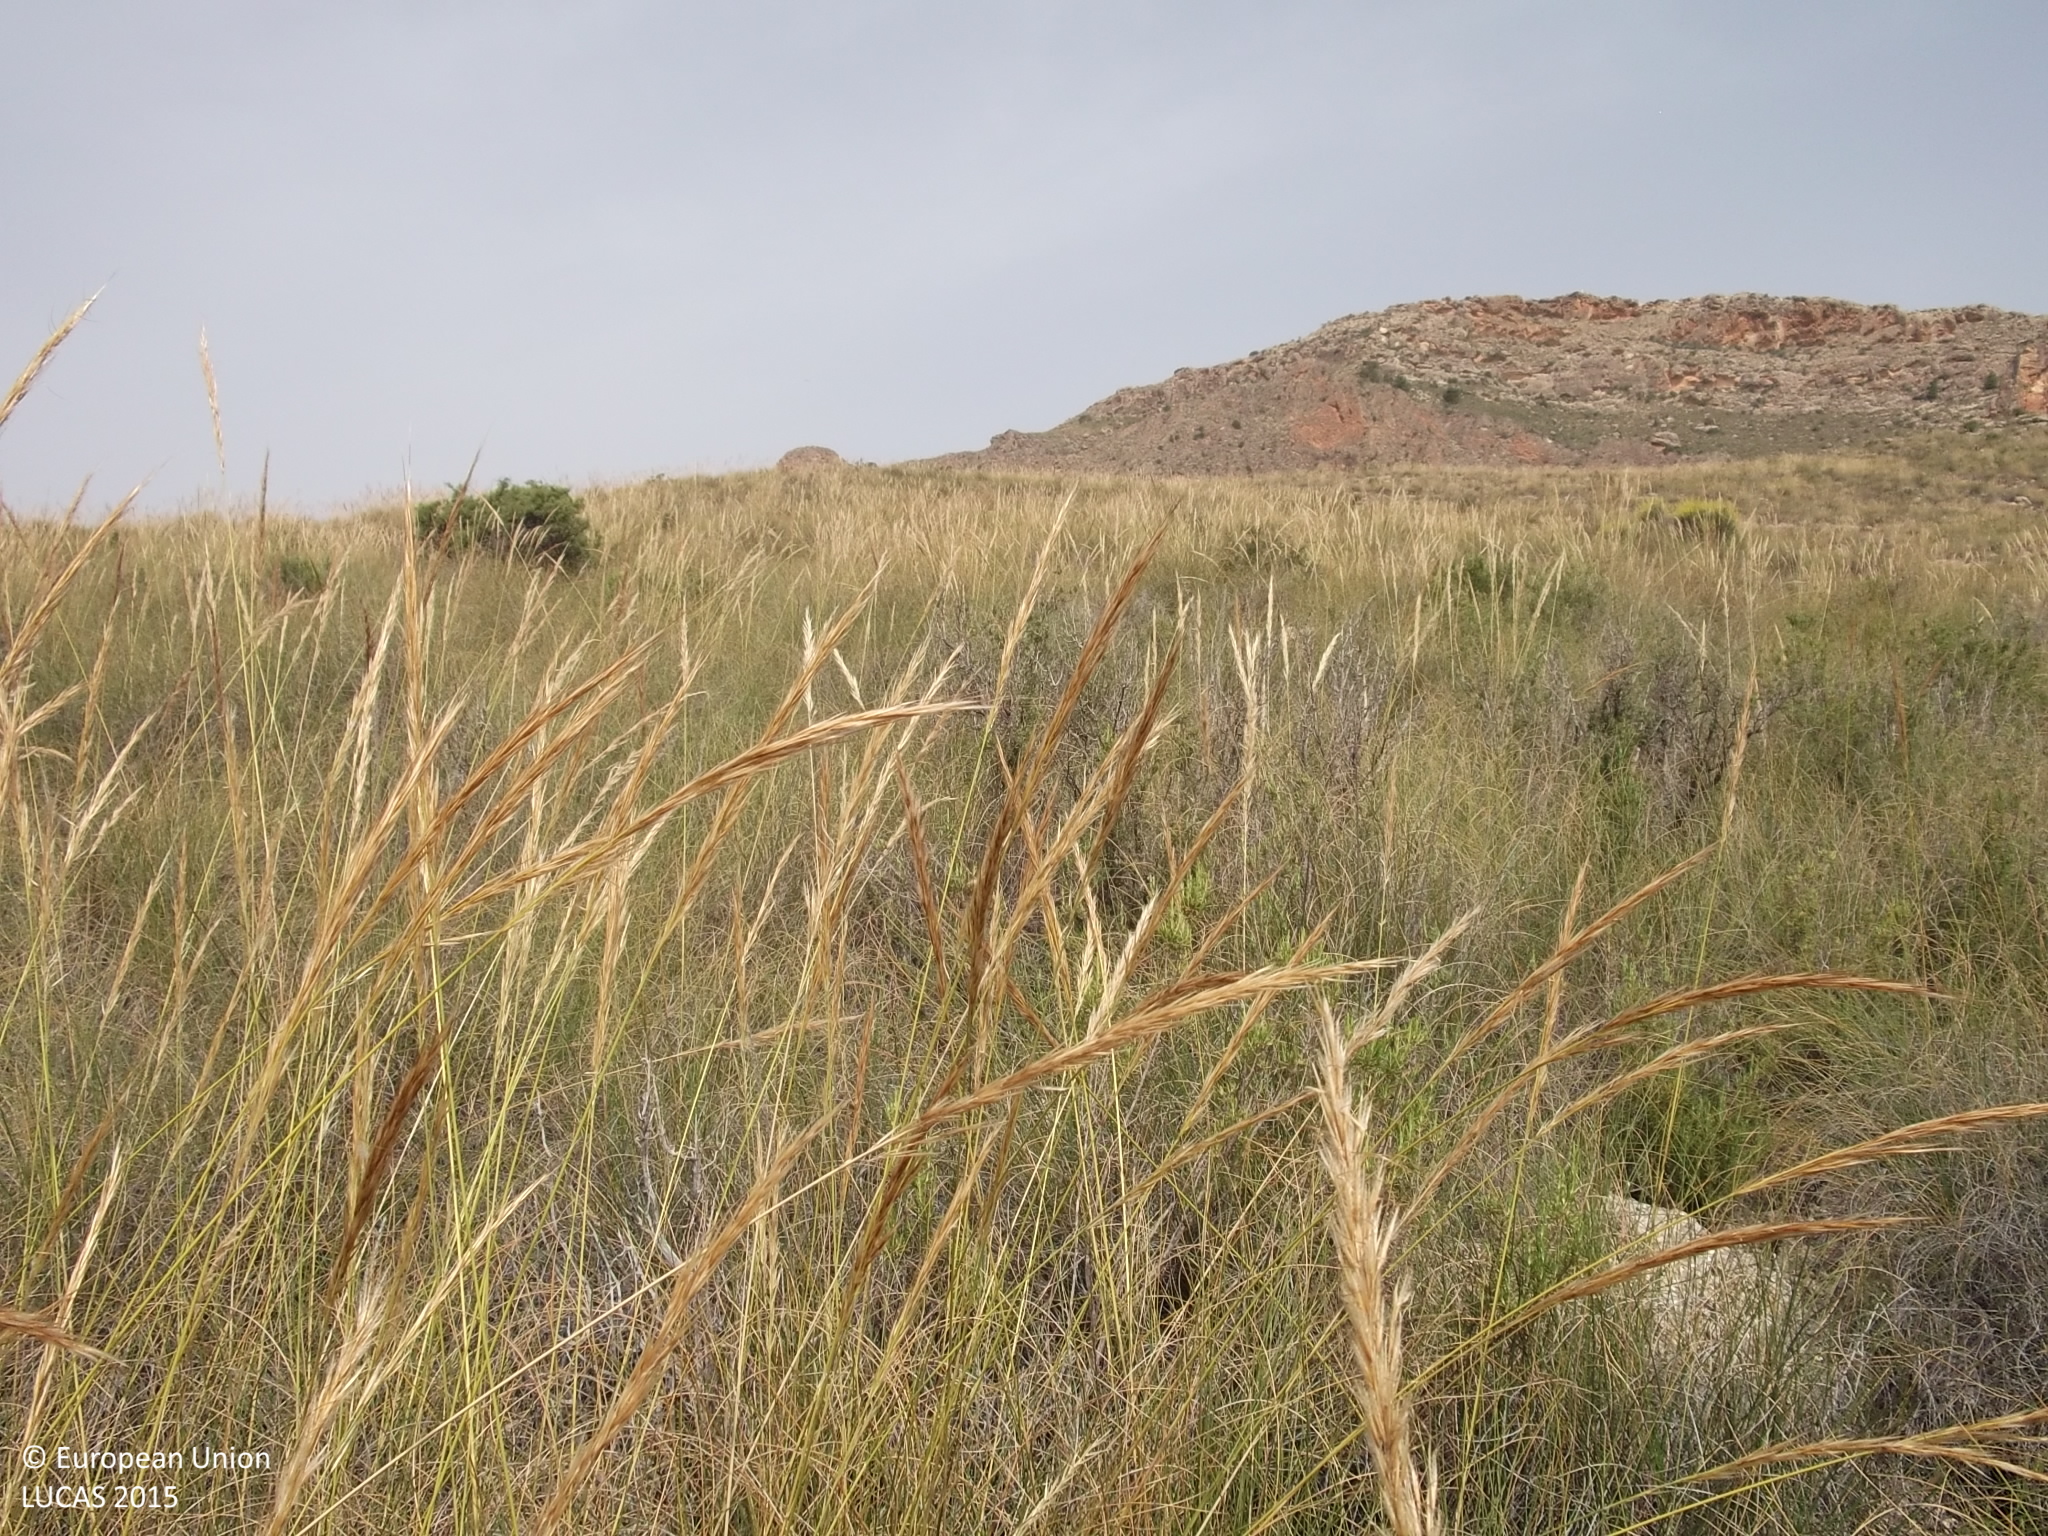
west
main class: Shrubland
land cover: Shrubland without tree cover
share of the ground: 25 - 50 %
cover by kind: consolidated bare surface 50 %, shrubs 25 %, herbaceous plants 25 %
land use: Semi-natural and natural areas not in use
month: May
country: ES
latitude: 38.4413
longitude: -1.6209
